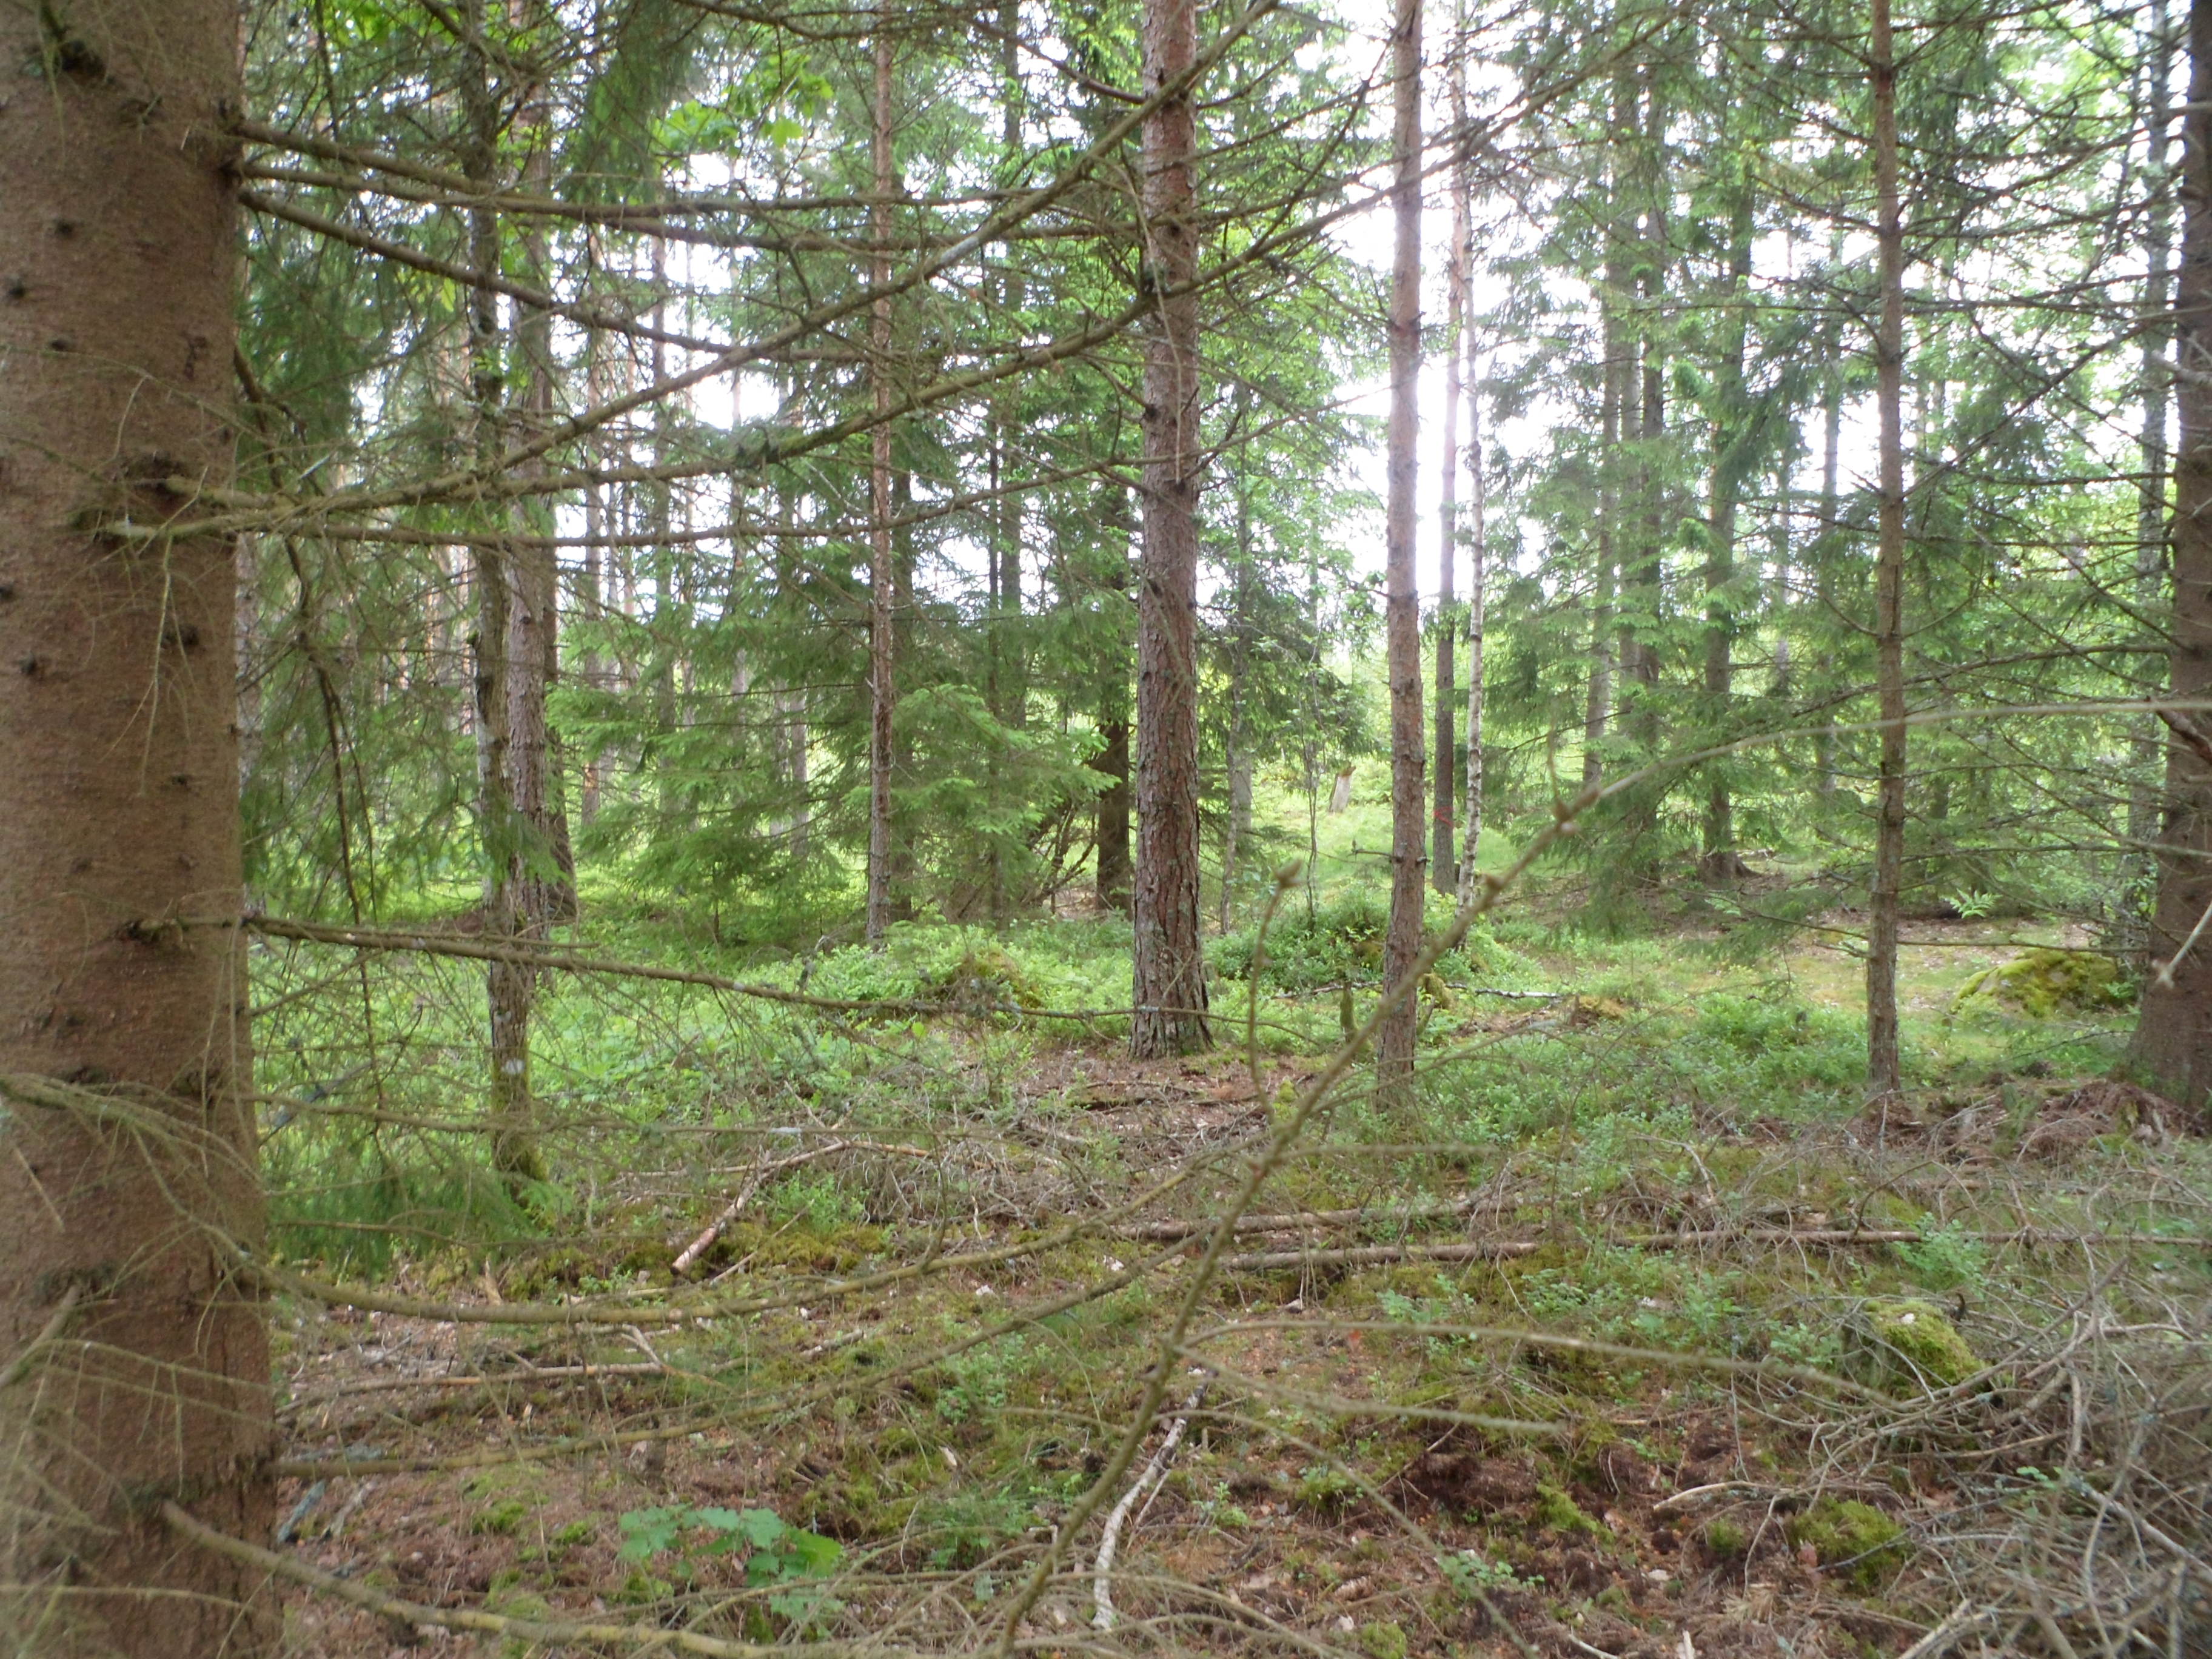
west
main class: Woodland
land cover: Pine dominated coniferous woodland
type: boreal forest
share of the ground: 50 - 75 %
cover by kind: coniferous forest trees 65 %, broadleaved forest trees 10 %, shrubs 10 %, lichens and mosses 10 %, herbaceous plants 5 %
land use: Forestry
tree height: > 5 m
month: June
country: SE
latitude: 56.9200
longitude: 14.4814
